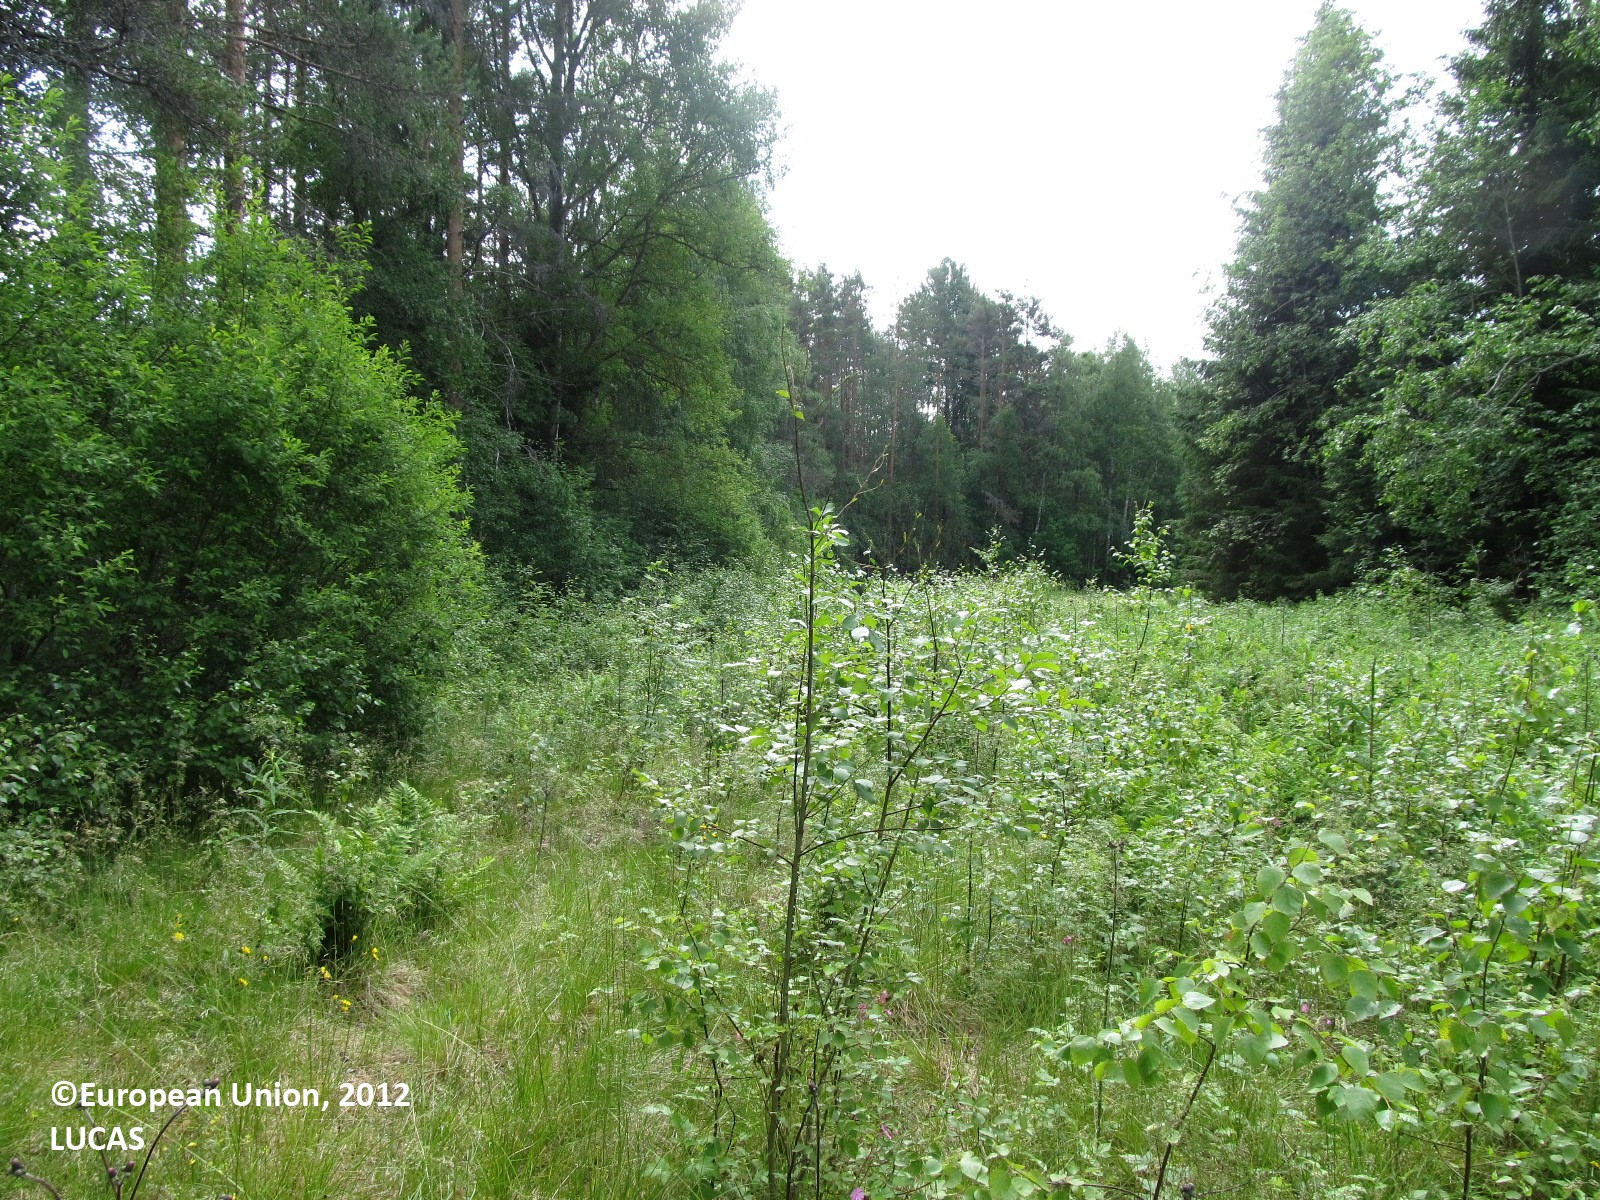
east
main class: Grassland
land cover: Grassland with sparse tree/shrub cover
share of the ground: > 75 %
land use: Semi-natural and natural areas not in use
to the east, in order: Grassland with sparse tree/shrub cover; Shrubland without tree cover; Pine dominated mixed woodland; Peatbogs; Inland water bodies; Peatbogs; Rivers and streams
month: July
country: FI
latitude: 61.8720
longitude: 29.1121
